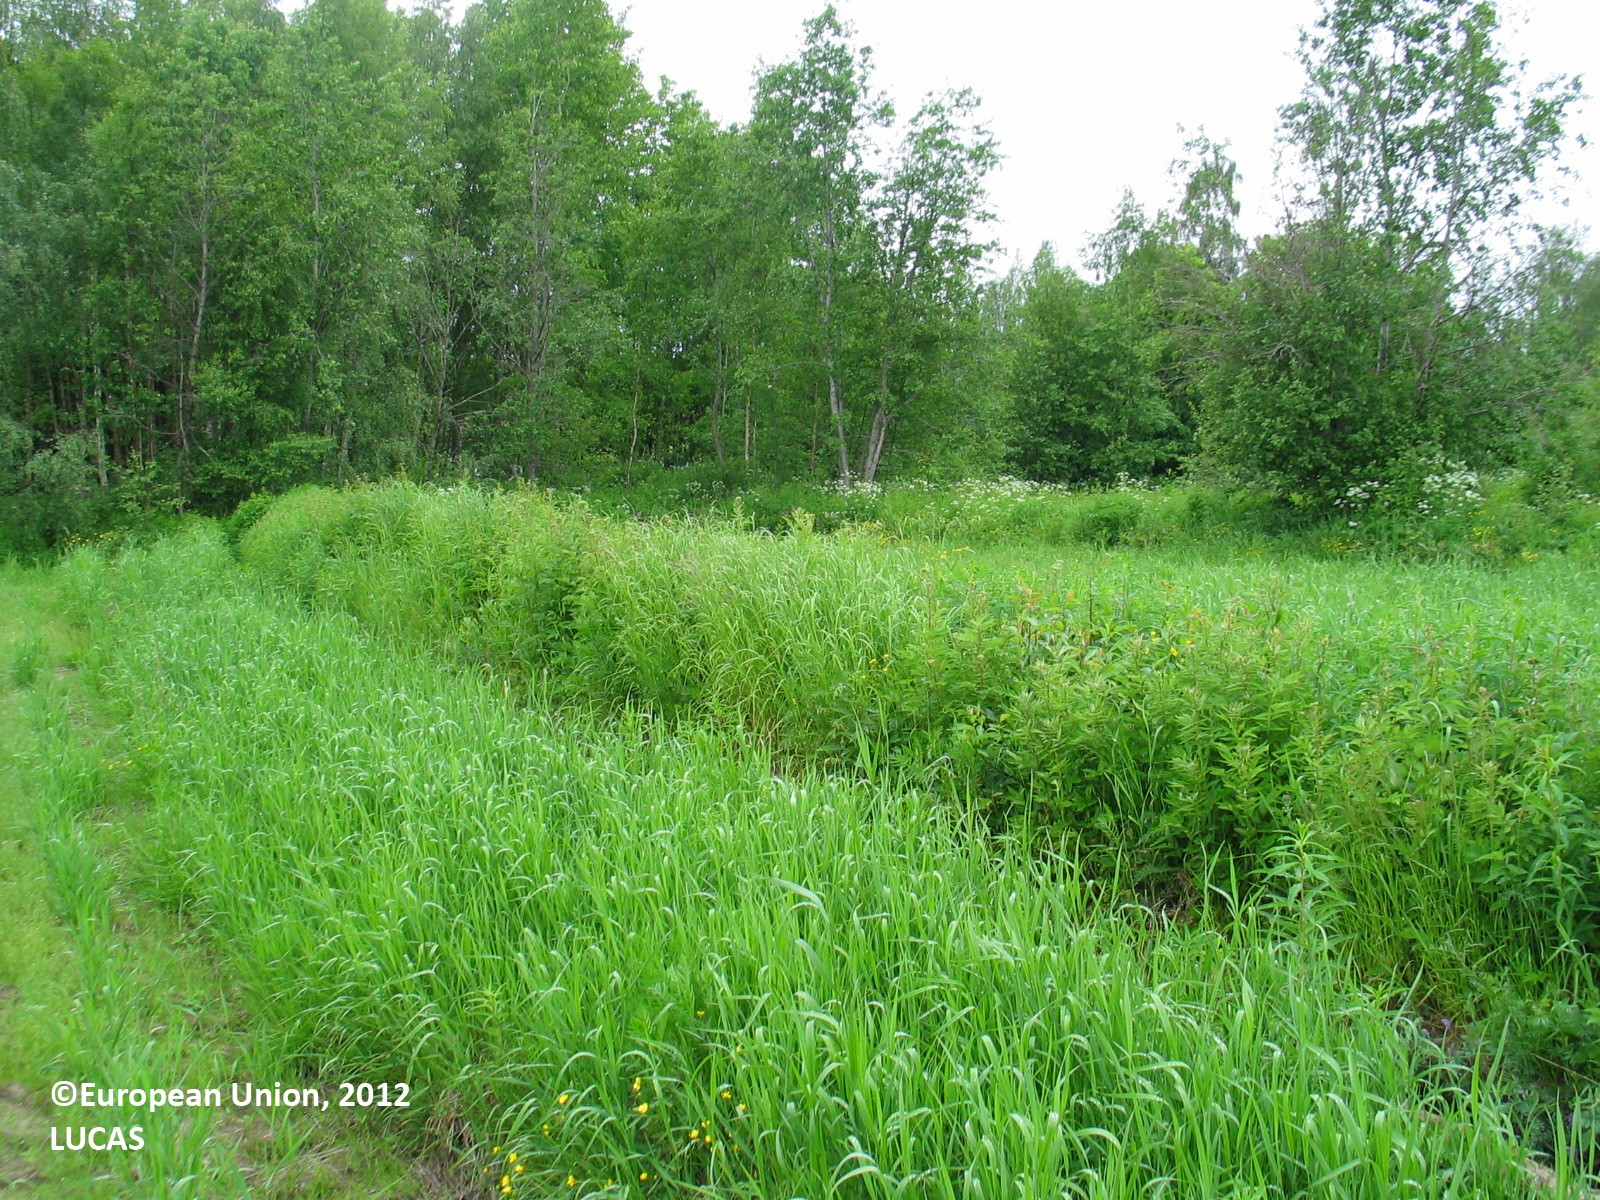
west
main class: Grassland
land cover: Grassland without tree/shrub cover
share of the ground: 25 - 50 %
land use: Agriculture (excluding fallow land and kitchen gardens)
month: June
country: FI
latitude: 65.1233
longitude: 25.3547
